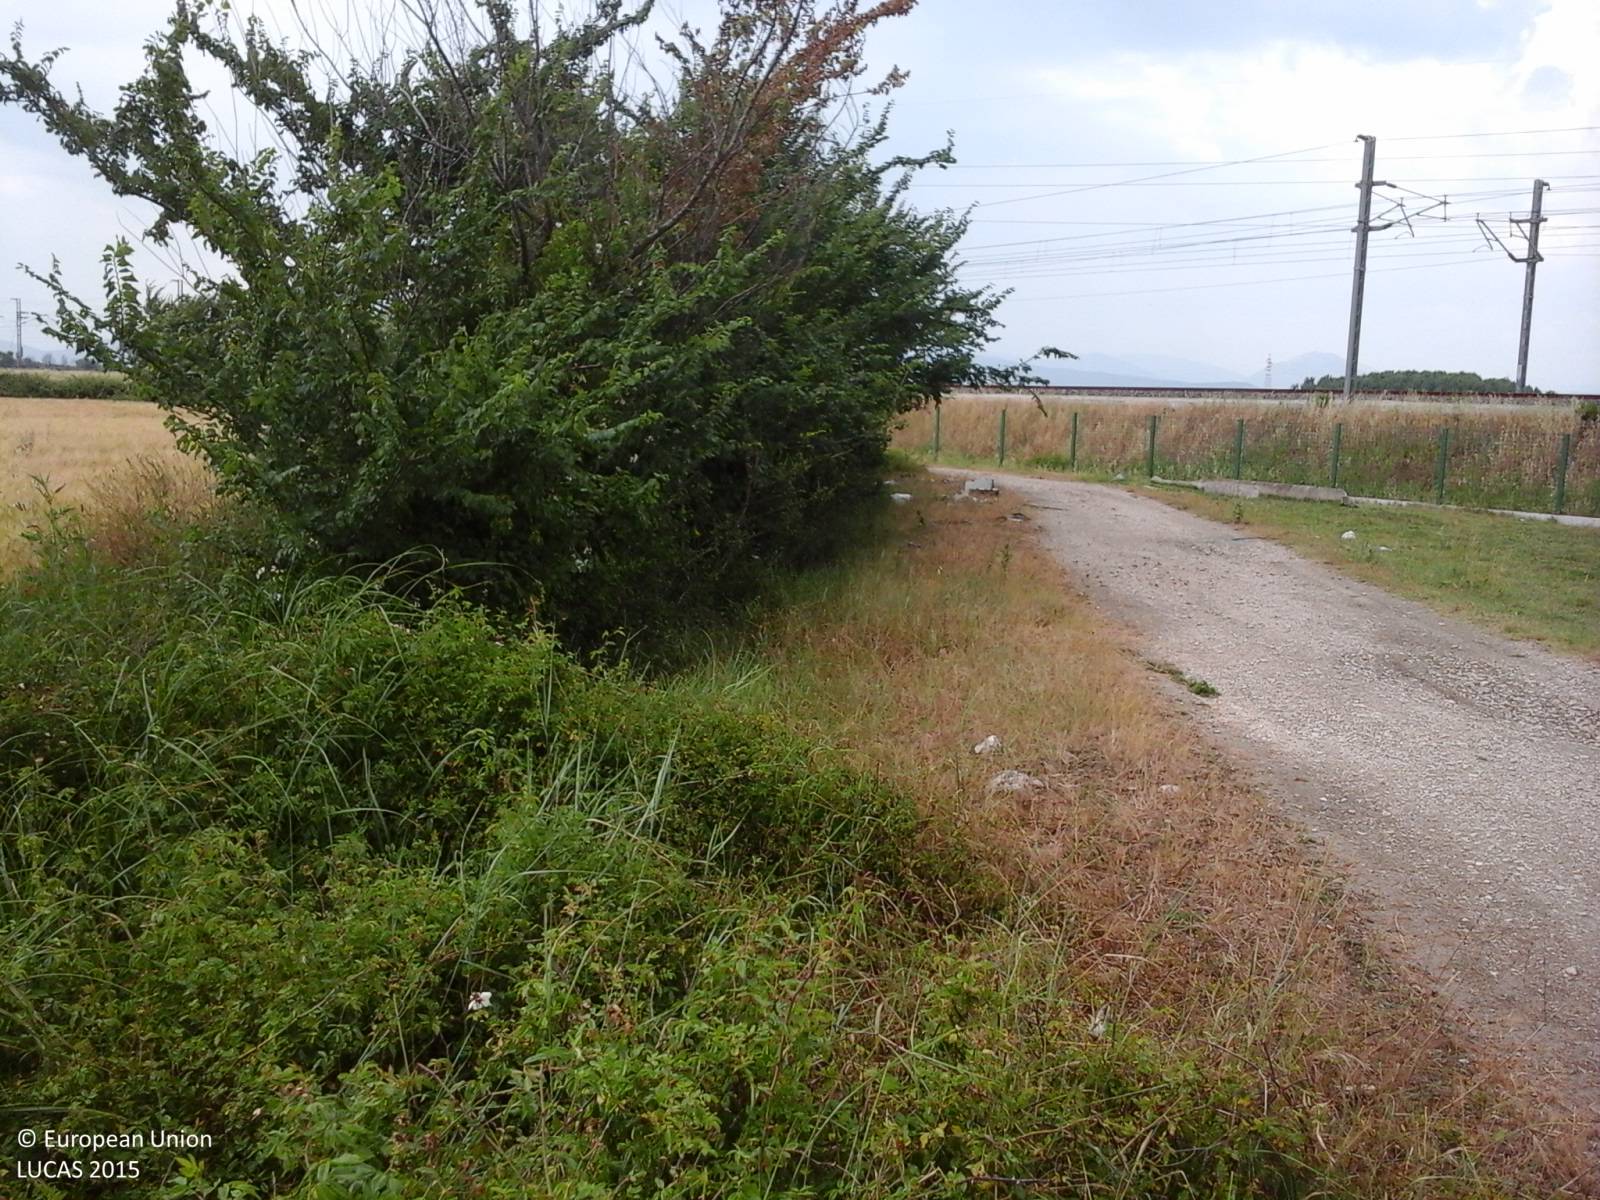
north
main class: Cropland
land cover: Barley
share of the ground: > 75 %
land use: Agriculture (excluding fallow land and kitchen gardens)
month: June
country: IT
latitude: 41.0838
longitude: 14.1852
